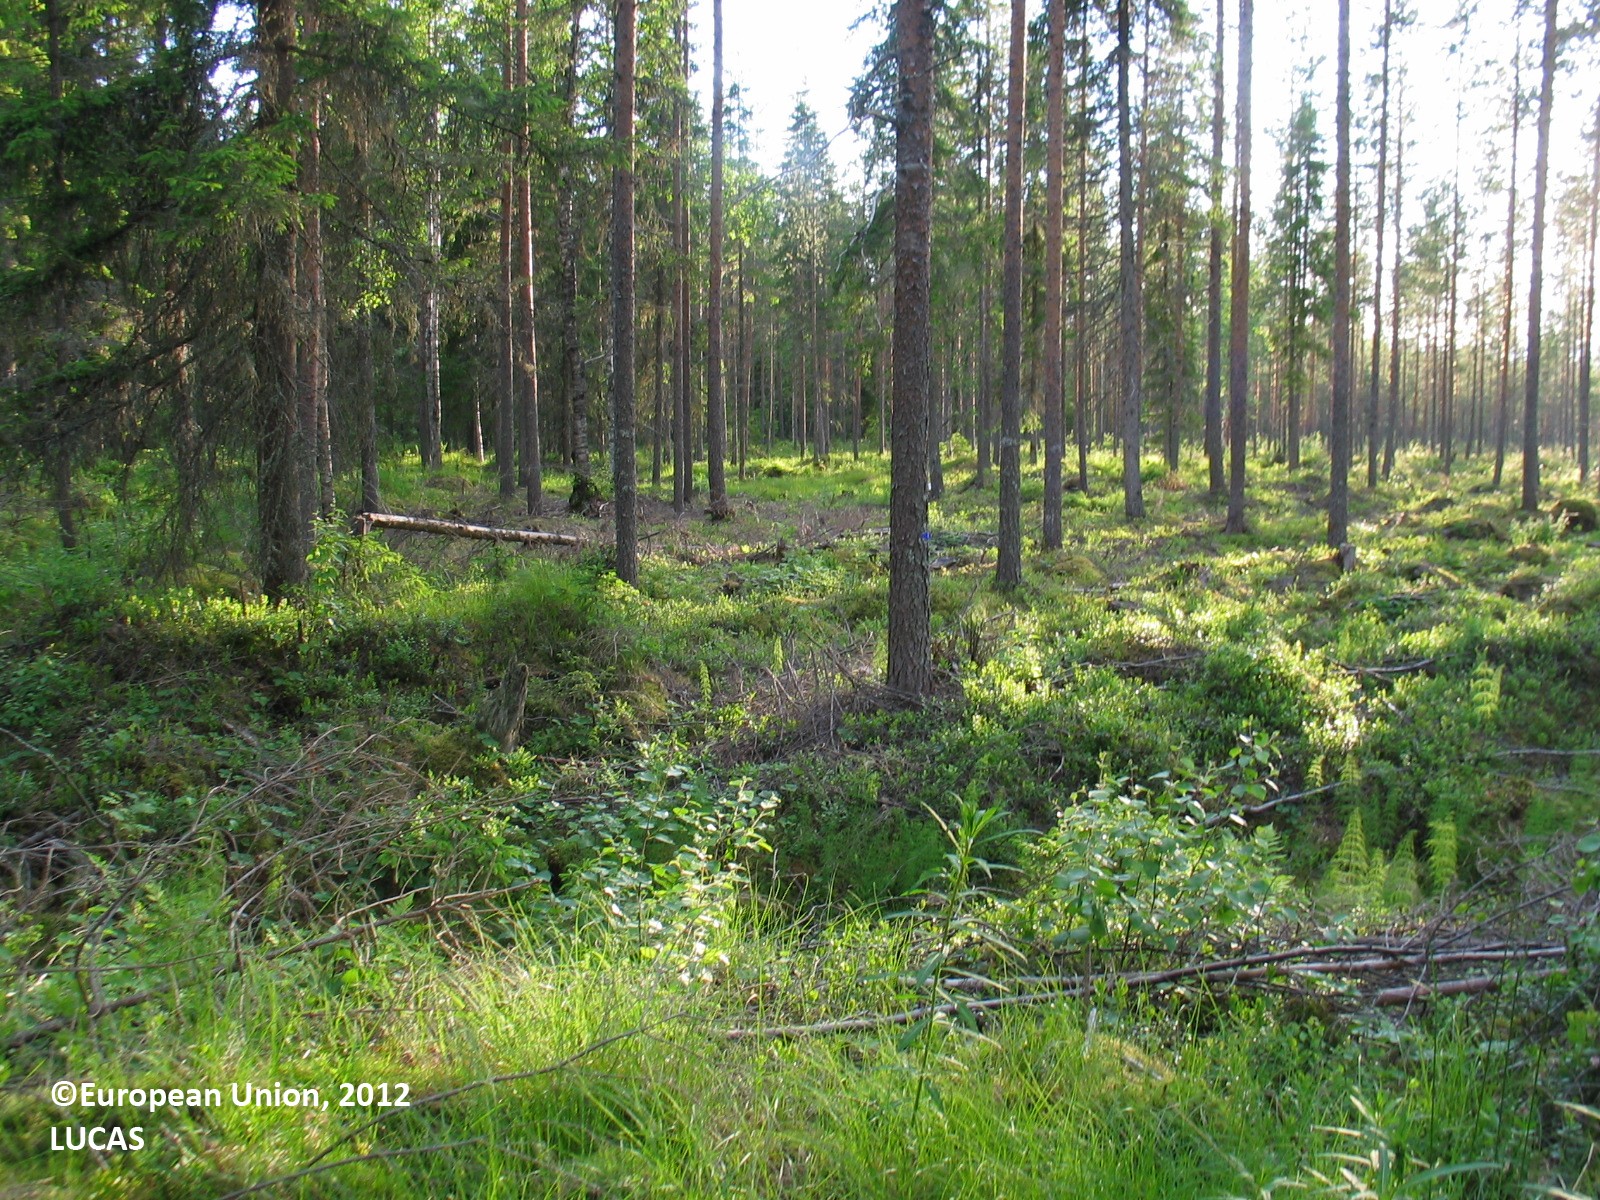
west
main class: Woodland
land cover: Other coniferous woodland
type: boreal forest
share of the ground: 25 - 50 %
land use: Forestry
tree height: > 5 m
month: June
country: FI
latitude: 64.9479
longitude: 26.5558
